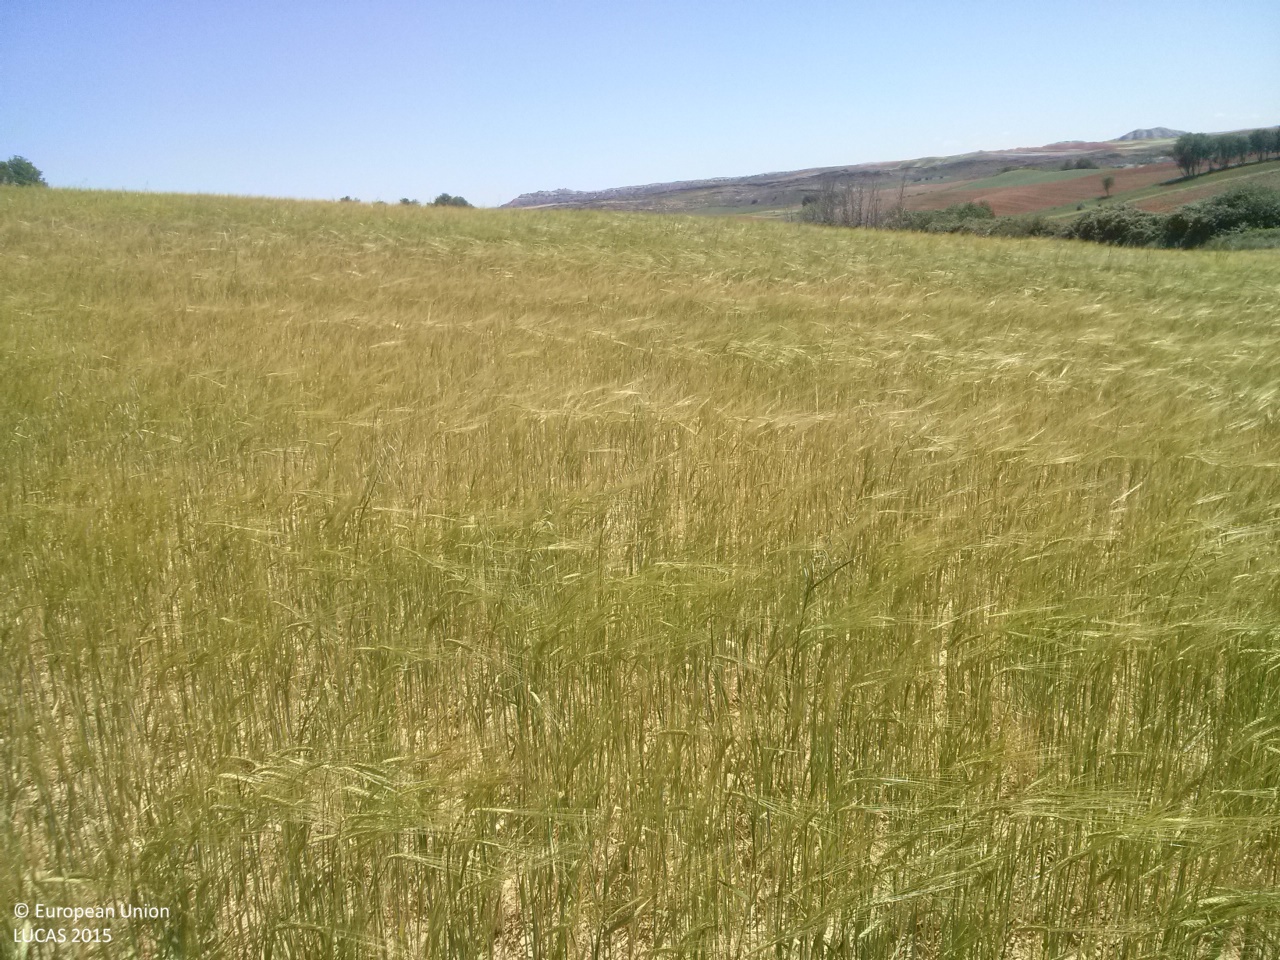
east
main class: Cropland
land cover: Barley
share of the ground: > 75 %
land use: Agriculture (excluding fallow land and kitchen gardens)
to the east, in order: Barley; Grass margins; Tracks; Grass margins; Sunflower; Grass margins; Abandoned hedges; Rivers and streams; Abandoned hedges; Grass margins; Sunflower; Grass margins; Barley; Grass margins; Fences; Broadleaved woodland; Abandoned hedges; Sunflower
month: May
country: ES
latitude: 40.2122
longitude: -2.7960
